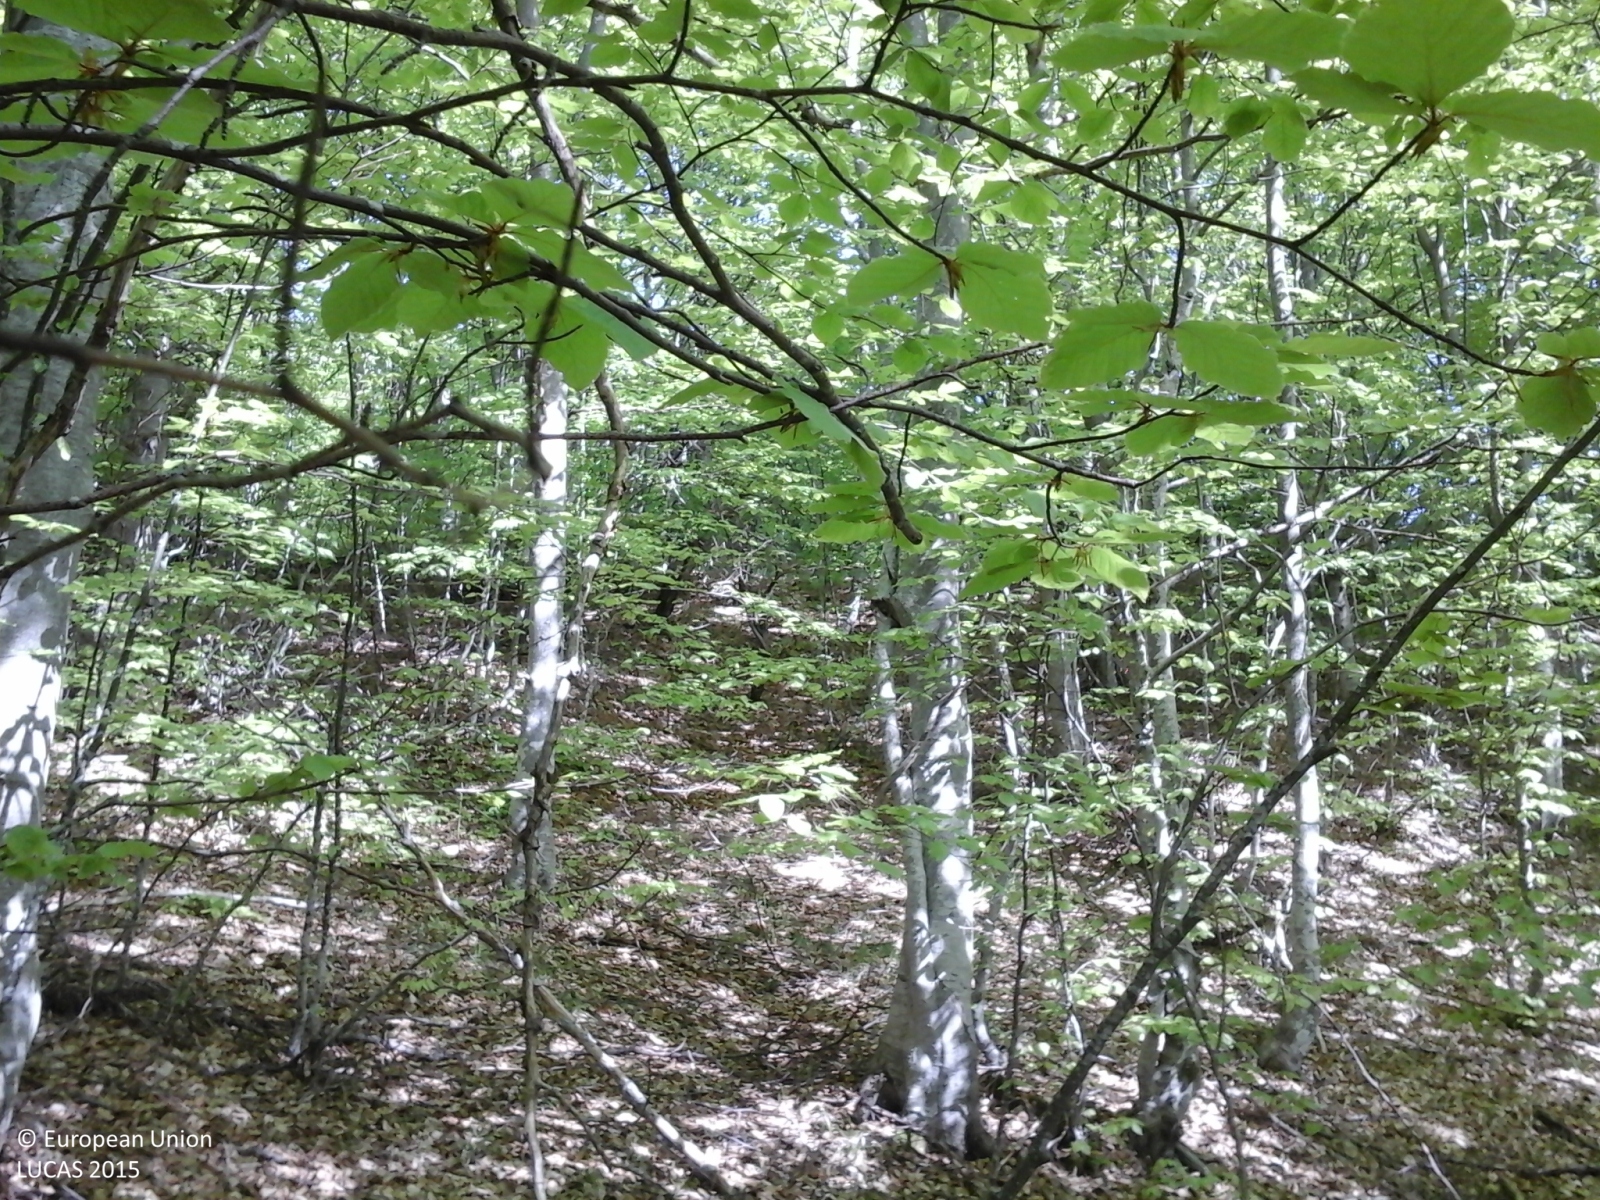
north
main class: Woodland
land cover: Broadleaved woodland
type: mountainous beech forest
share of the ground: > 75 %
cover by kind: broadleaved forest trees 100 %
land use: Forestry
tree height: > 5 m
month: May
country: IT
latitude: 44.6722
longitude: 9.2070
